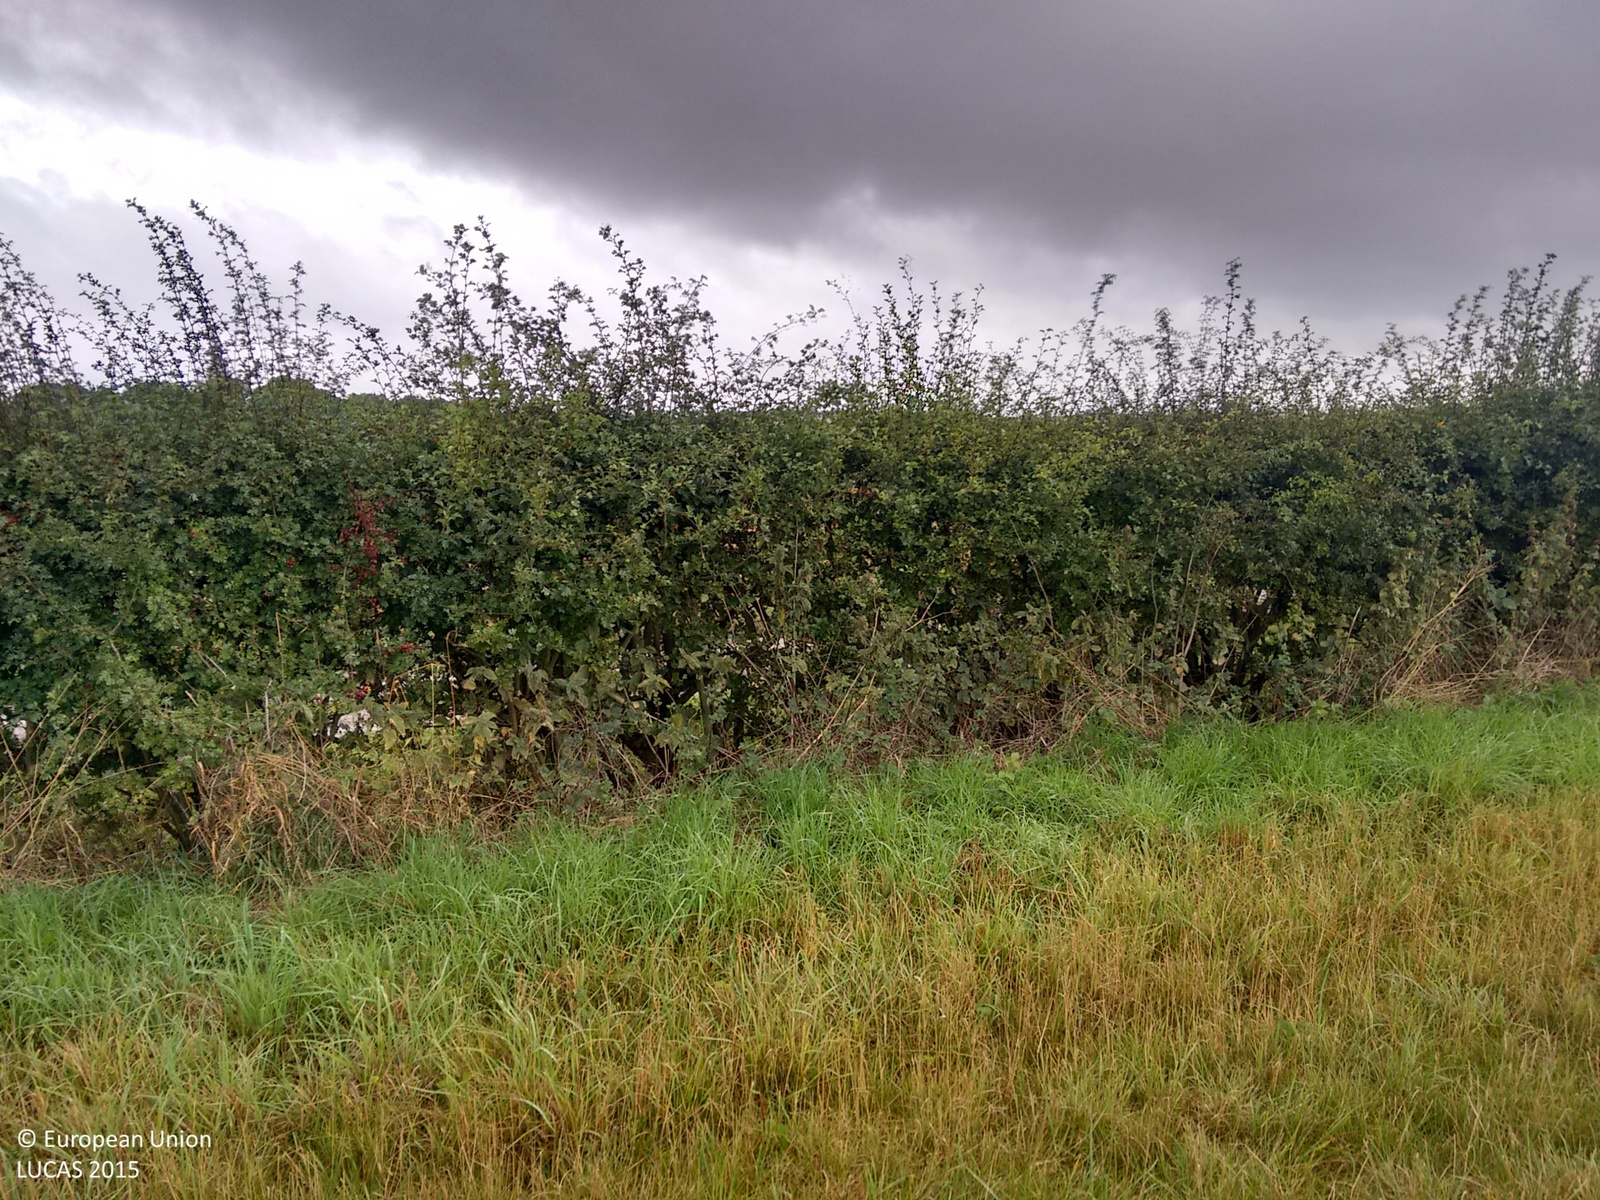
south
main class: Cropland
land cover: Common wheat
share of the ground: > 75 %
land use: Agriculture (excluding fallow land and kitchen gardens)
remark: Harvested field
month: August
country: GB
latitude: 52.1196
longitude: 0.4642
